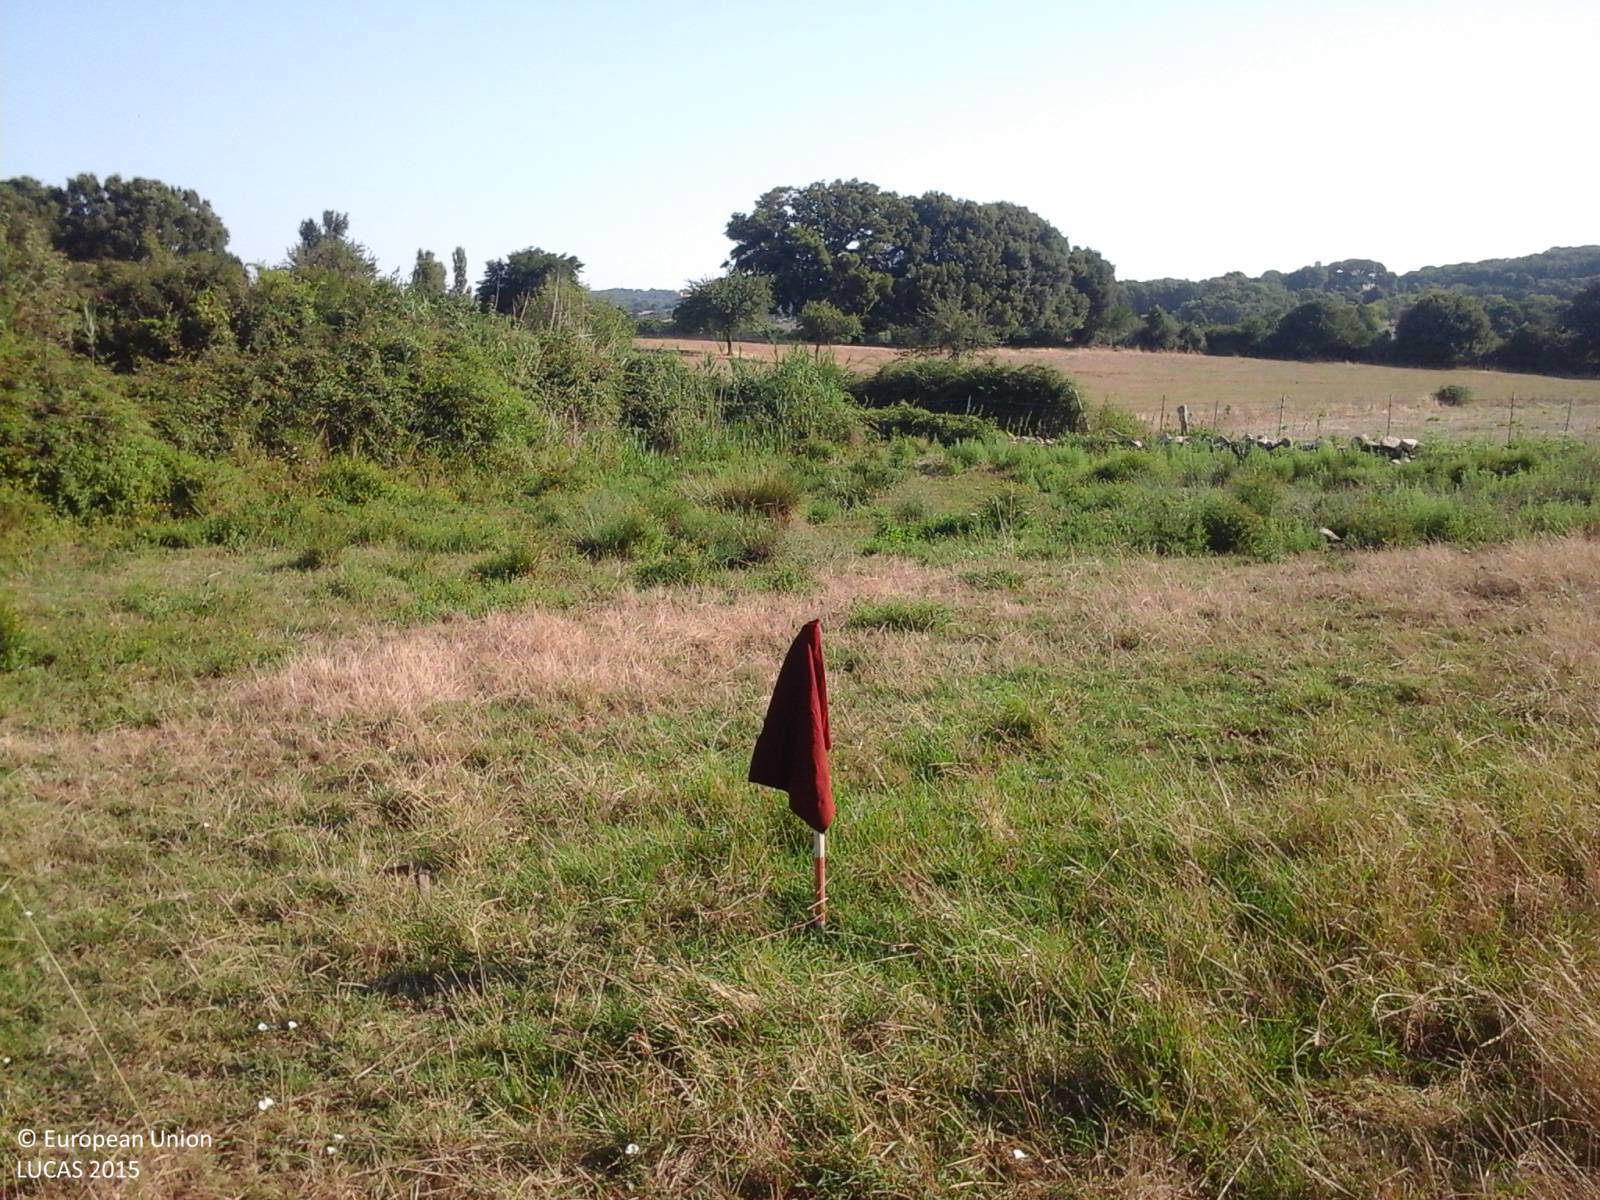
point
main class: Grassland
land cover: Grassland without tree/shrub cover
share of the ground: > 75 %
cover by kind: herbaceous plants 100 %
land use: Agriculture (excluding fallow land and kitchen gardens)
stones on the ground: < 10 %
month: August
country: IT
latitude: 40.9152
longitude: 9.1609
